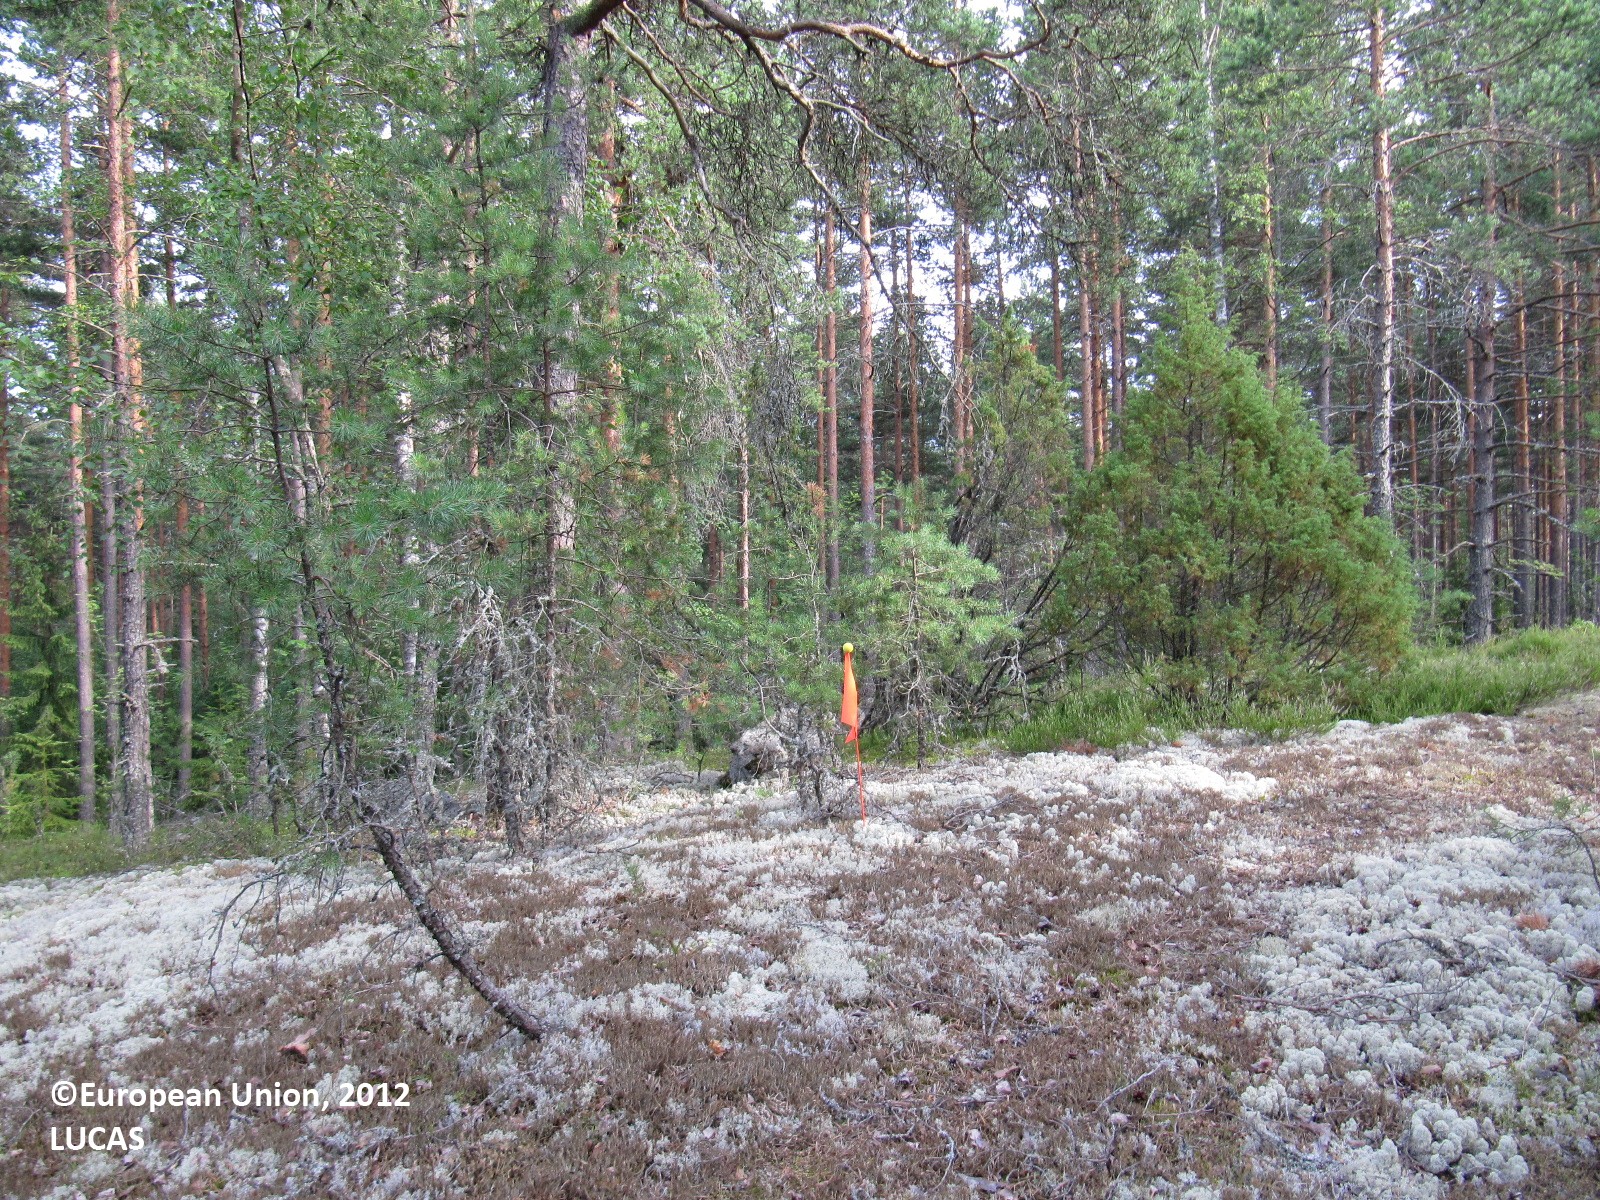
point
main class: Woodland
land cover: Pine dominated coniferous woodland
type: boreal forest
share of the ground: > 75 %
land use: Forestry
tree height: > 5 m
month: August
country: FI
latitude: 60.3516
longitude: 23.1112
